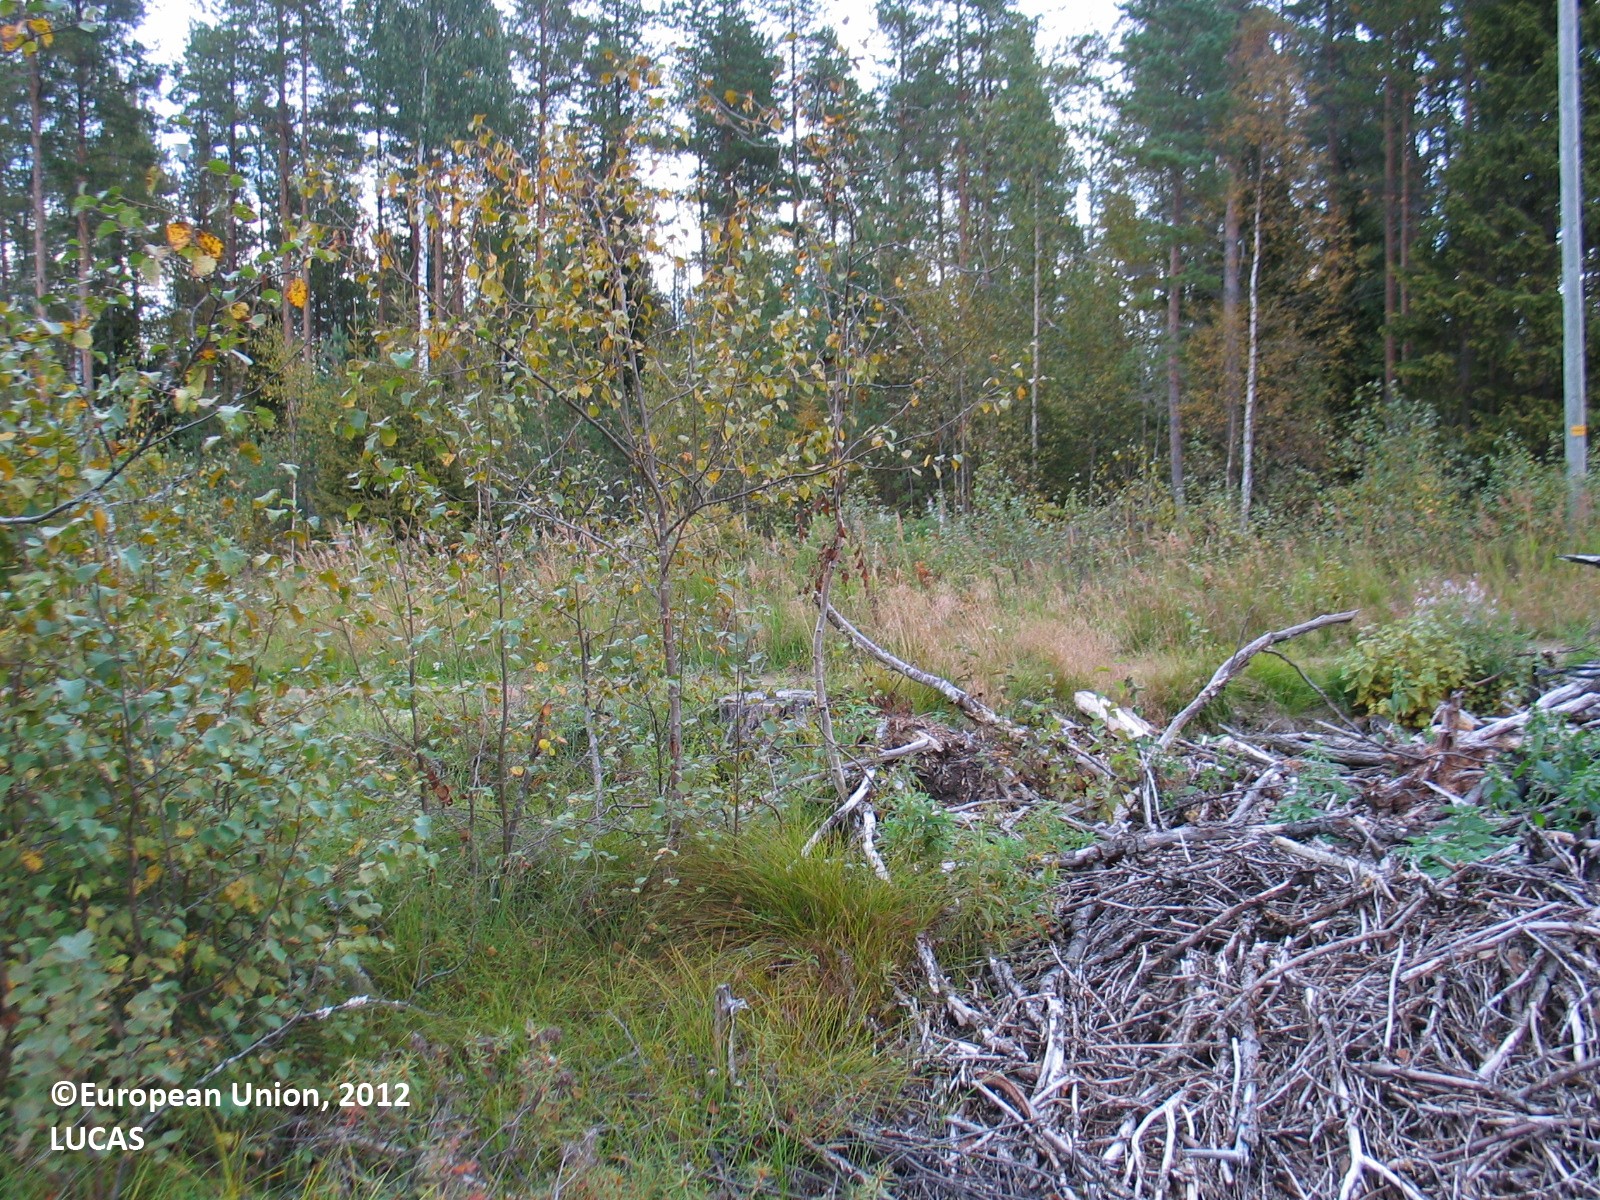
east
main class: Shrubland
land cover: Shrubland with sparse tree cover
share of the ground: 50 - 75 %
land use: Forestry
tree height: < 5 m
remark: Clear cut
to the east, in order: Shrubland with sparse tree cover; Grass margins; Tracks; Grass margins; Ditches and canals; Grassland with sparse tree/shrub cover; Electric lines; Grassland with sparse tree/shrub cover; Other mixed woodland; Ditches and canals; Other mixed woodland; Ditches and canals; Other mixed woodland; Pine dominated coniferous woodland; Ditches and canals; Pine dominated coniferous woodland; Ditches and canals; Pine dominated coniferous woodland; Ditches and canals; Pine dominated coniferous woodland; Ditches and canals; Pine dominated coniferous woodland; Ditches and canals; Pine dominated mixed woodland
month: September
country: FI
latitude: 65.3123
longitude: 25.5079
